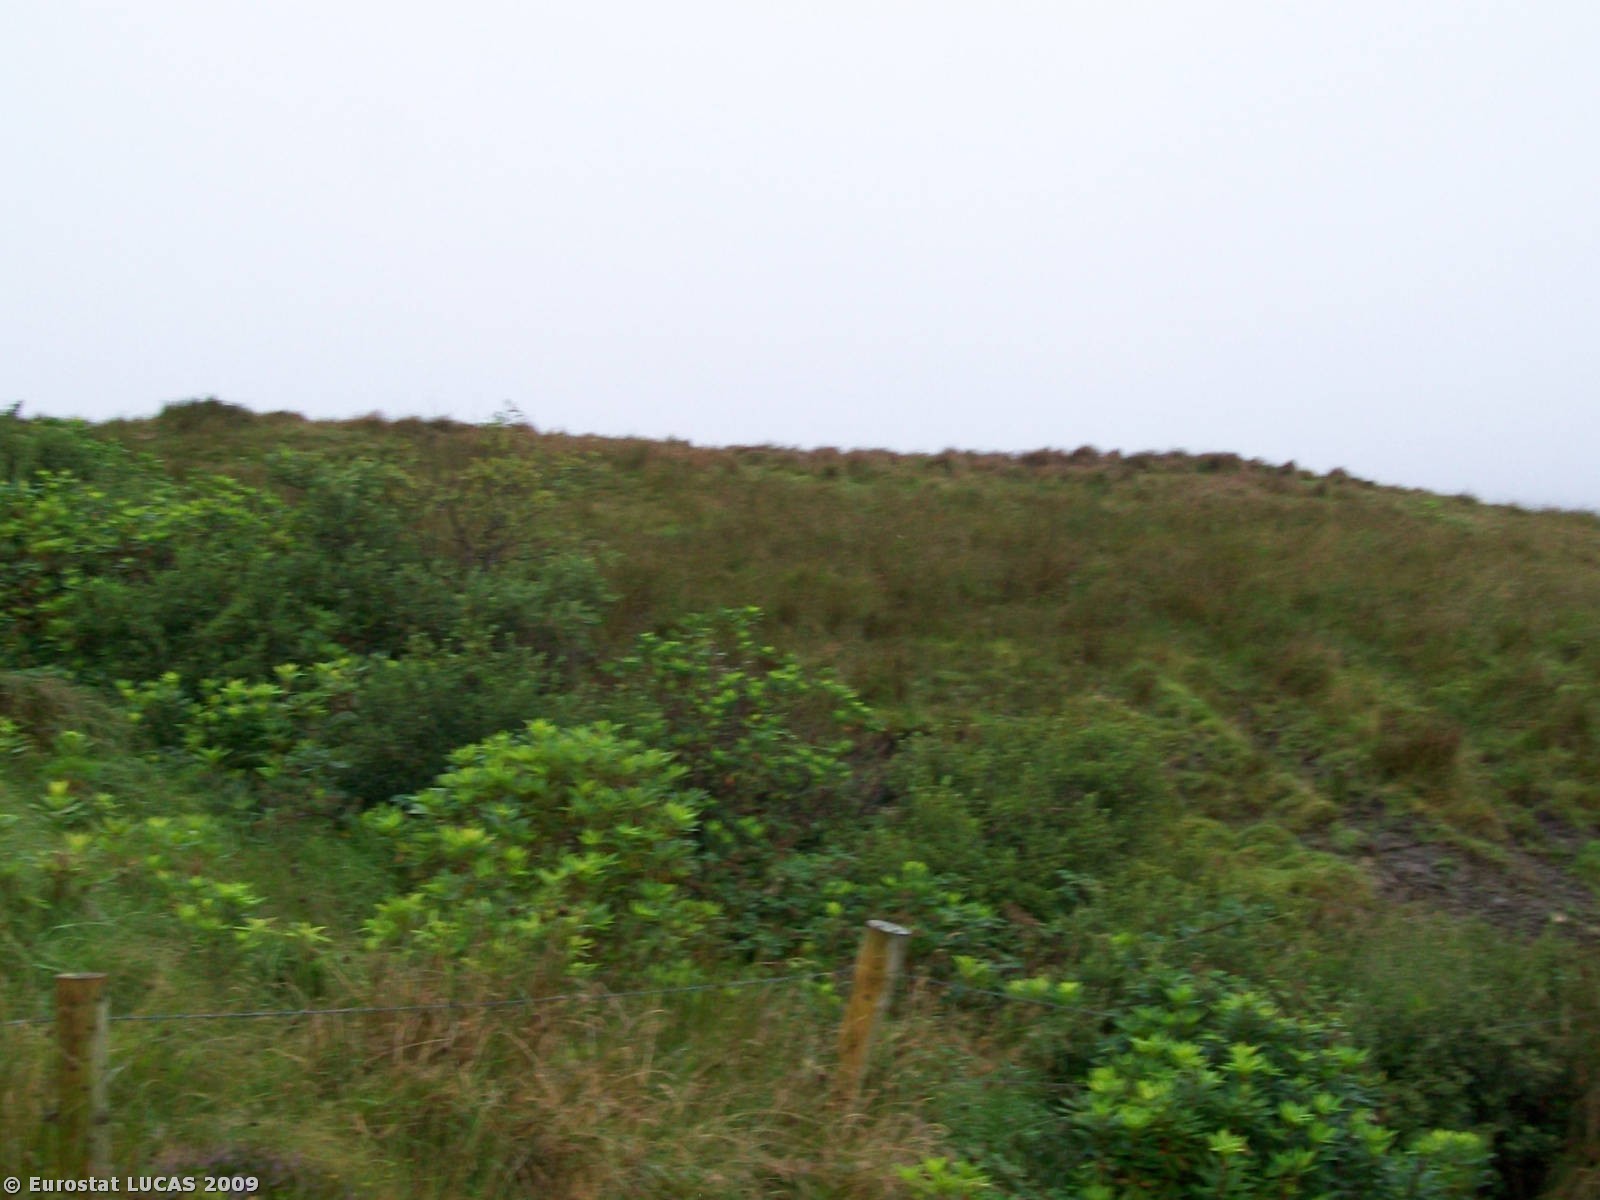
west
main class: Grassland
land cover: Grassland with sparse tree/shrub cover
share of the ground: > 75 %
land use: Agriculture (excluding fallow land and kitchen gardens)
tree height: < 5 m
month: August
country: IE
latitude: 52.8322
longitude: -9.2672
